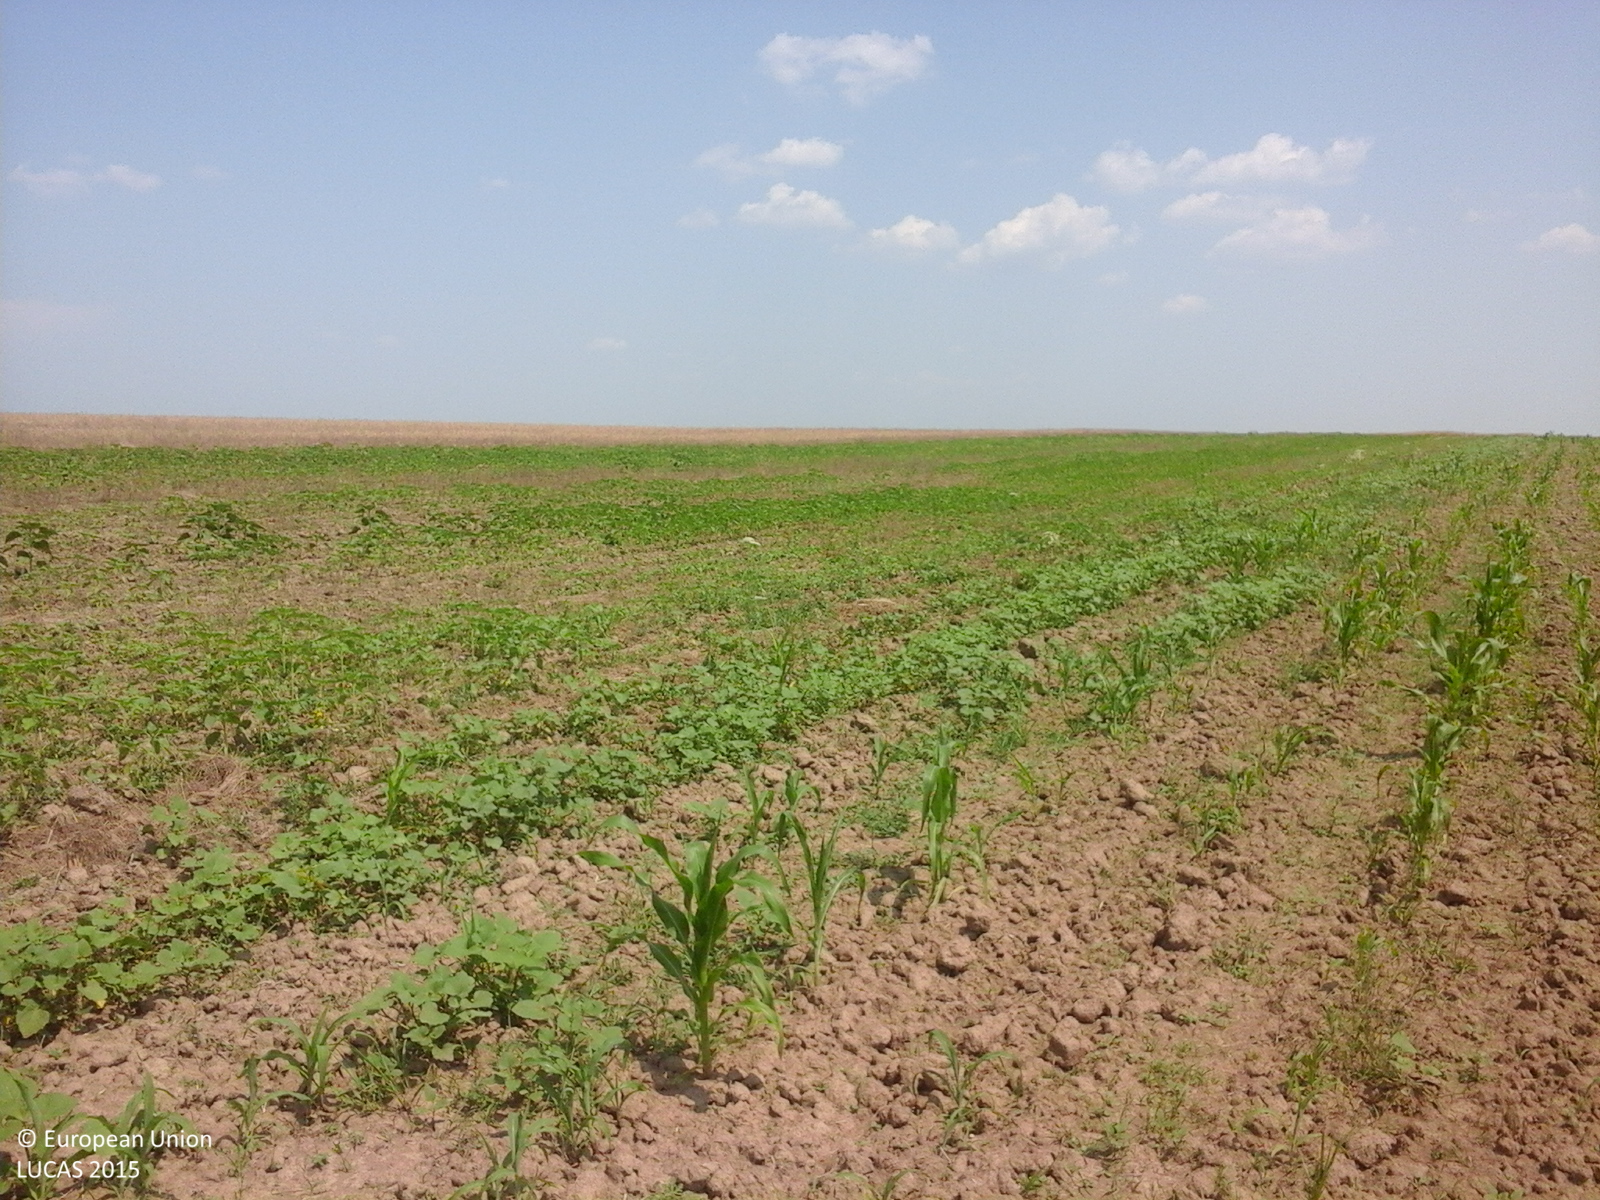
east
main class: Cropland
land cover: Maize
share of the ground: < 10 %
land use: Agriculture (excluding fallow land and kitchen gardens)
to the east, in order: Maize; Sunflower; Common wheat
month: July
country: RO
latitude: 44.7761
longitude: 24.4661
